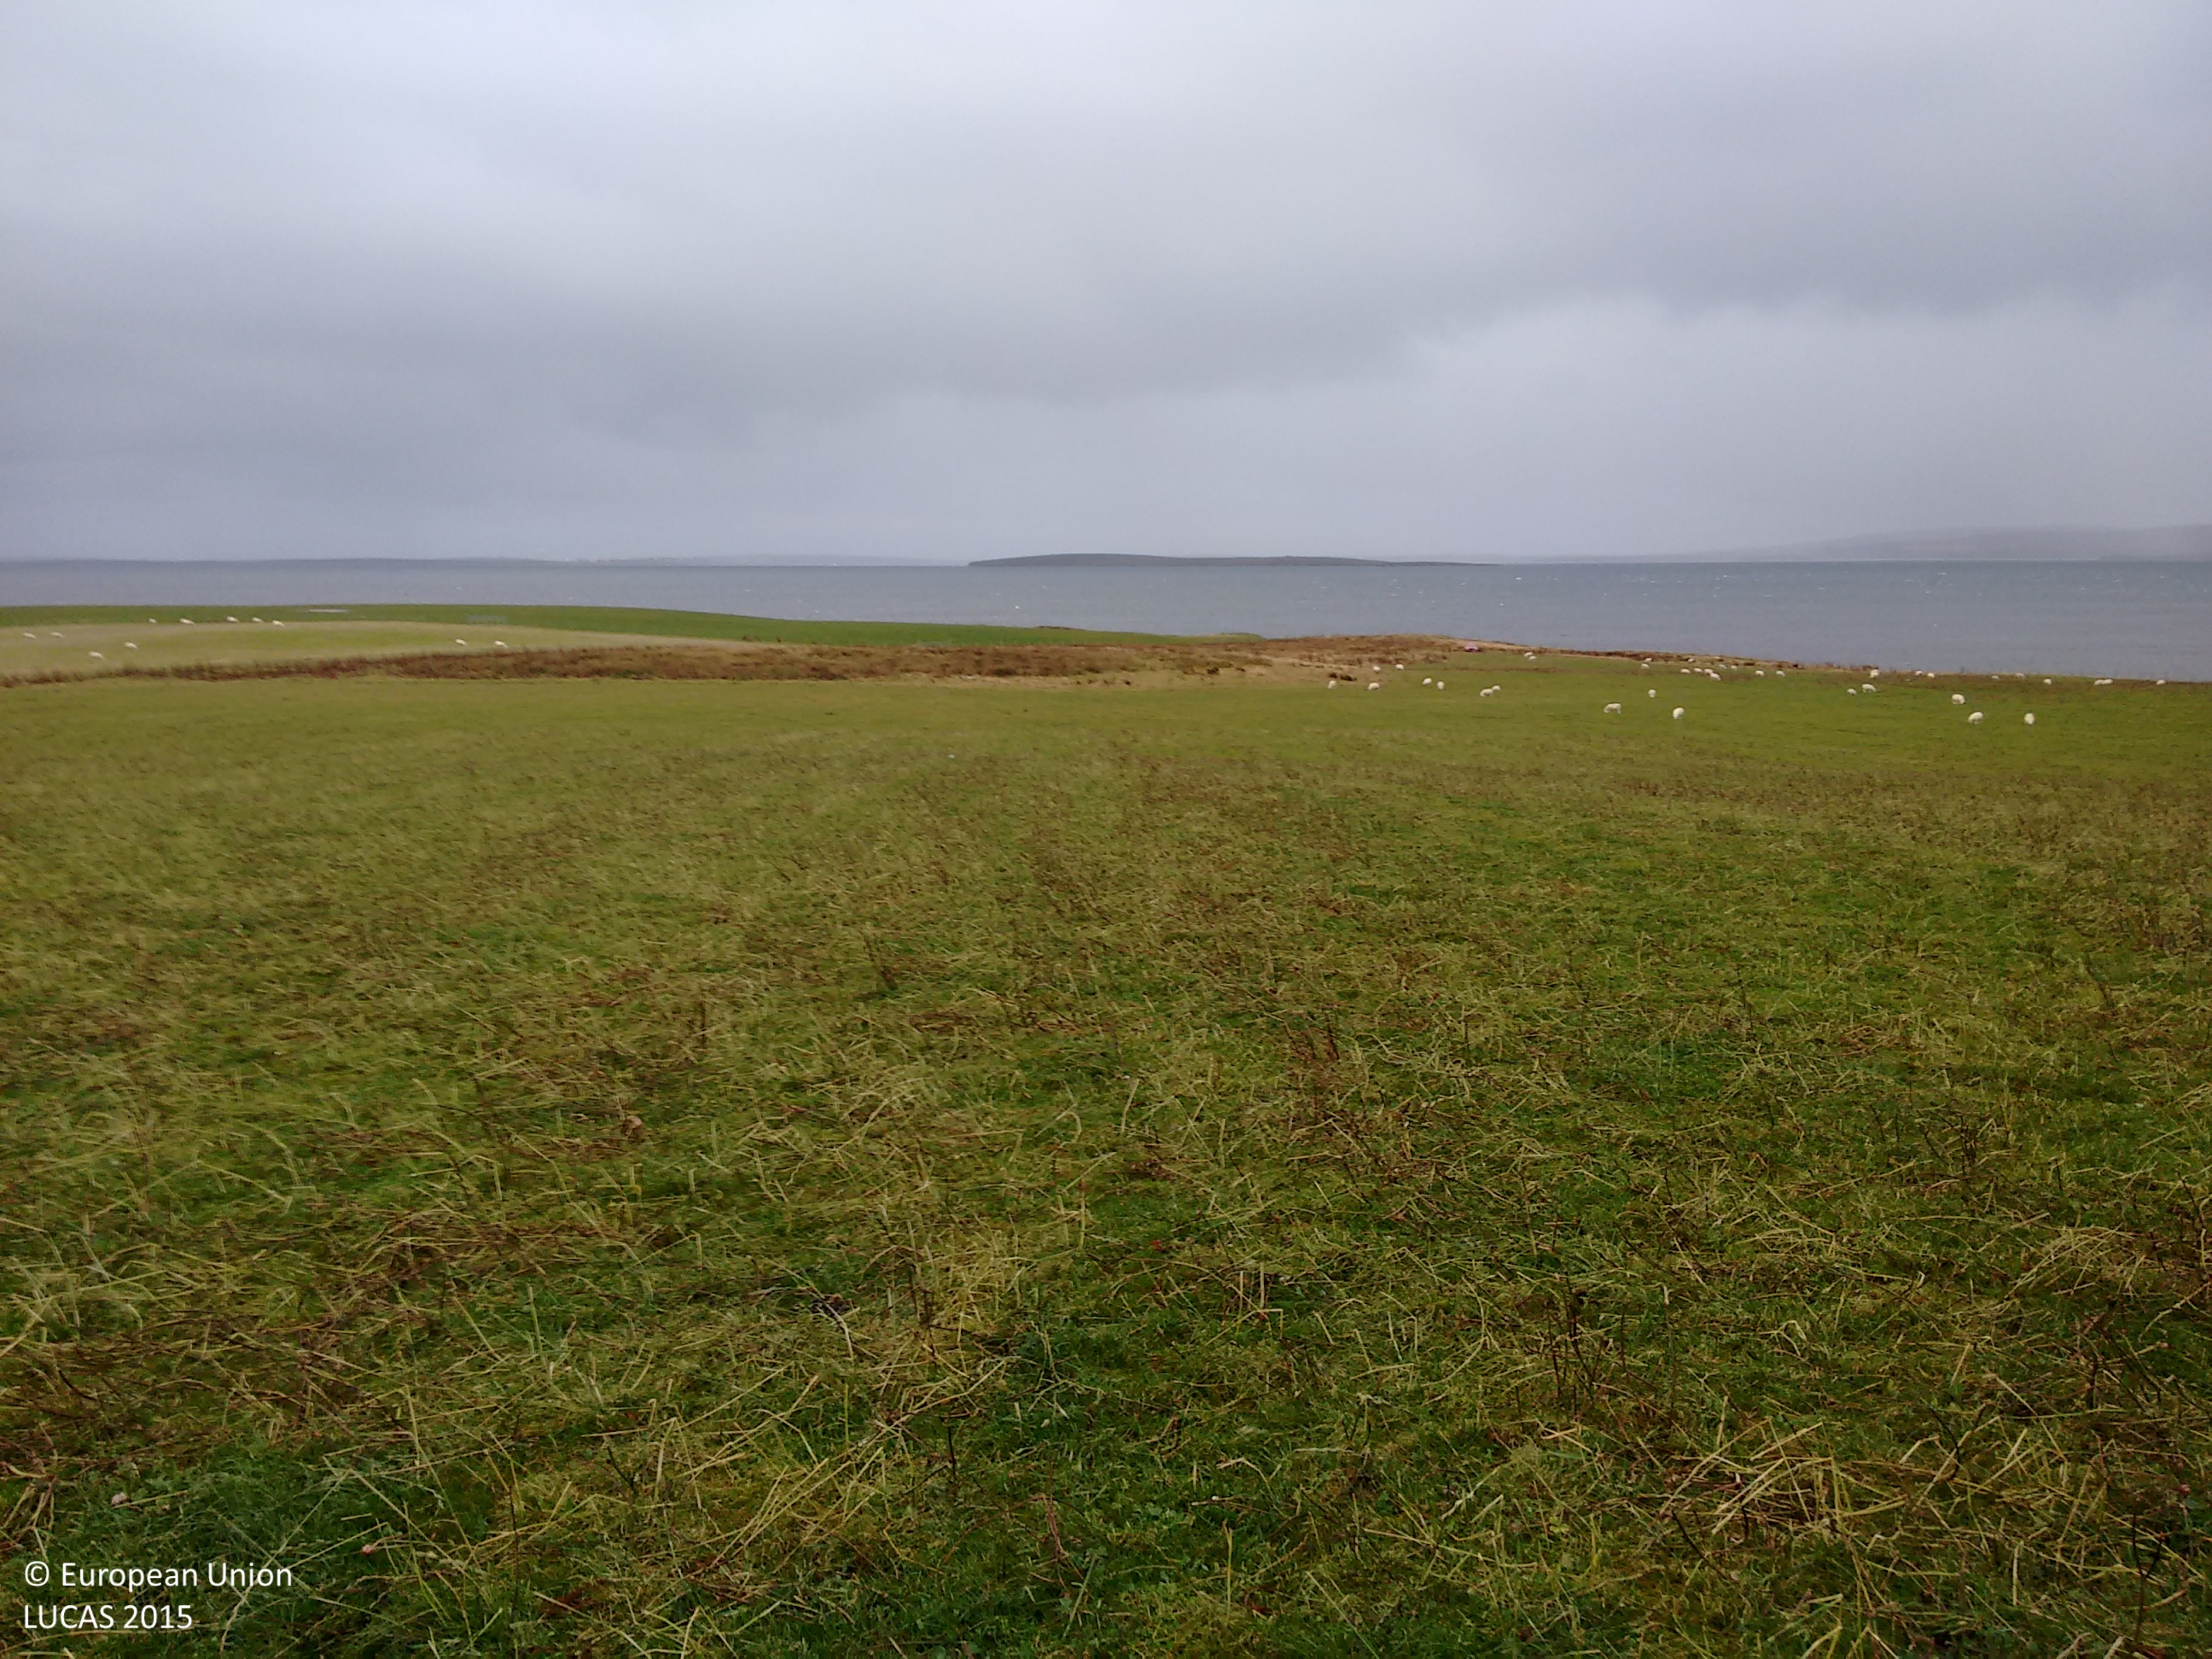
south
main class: Grassland
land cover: Grassland without tree/shrub cover
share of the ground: > 75 %
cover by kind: herbaceous plants 100 %
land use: Agriculture (excluding fallow land and kitchen gardens)
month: November
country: GB
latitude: 58.9198
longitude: -3.1680
